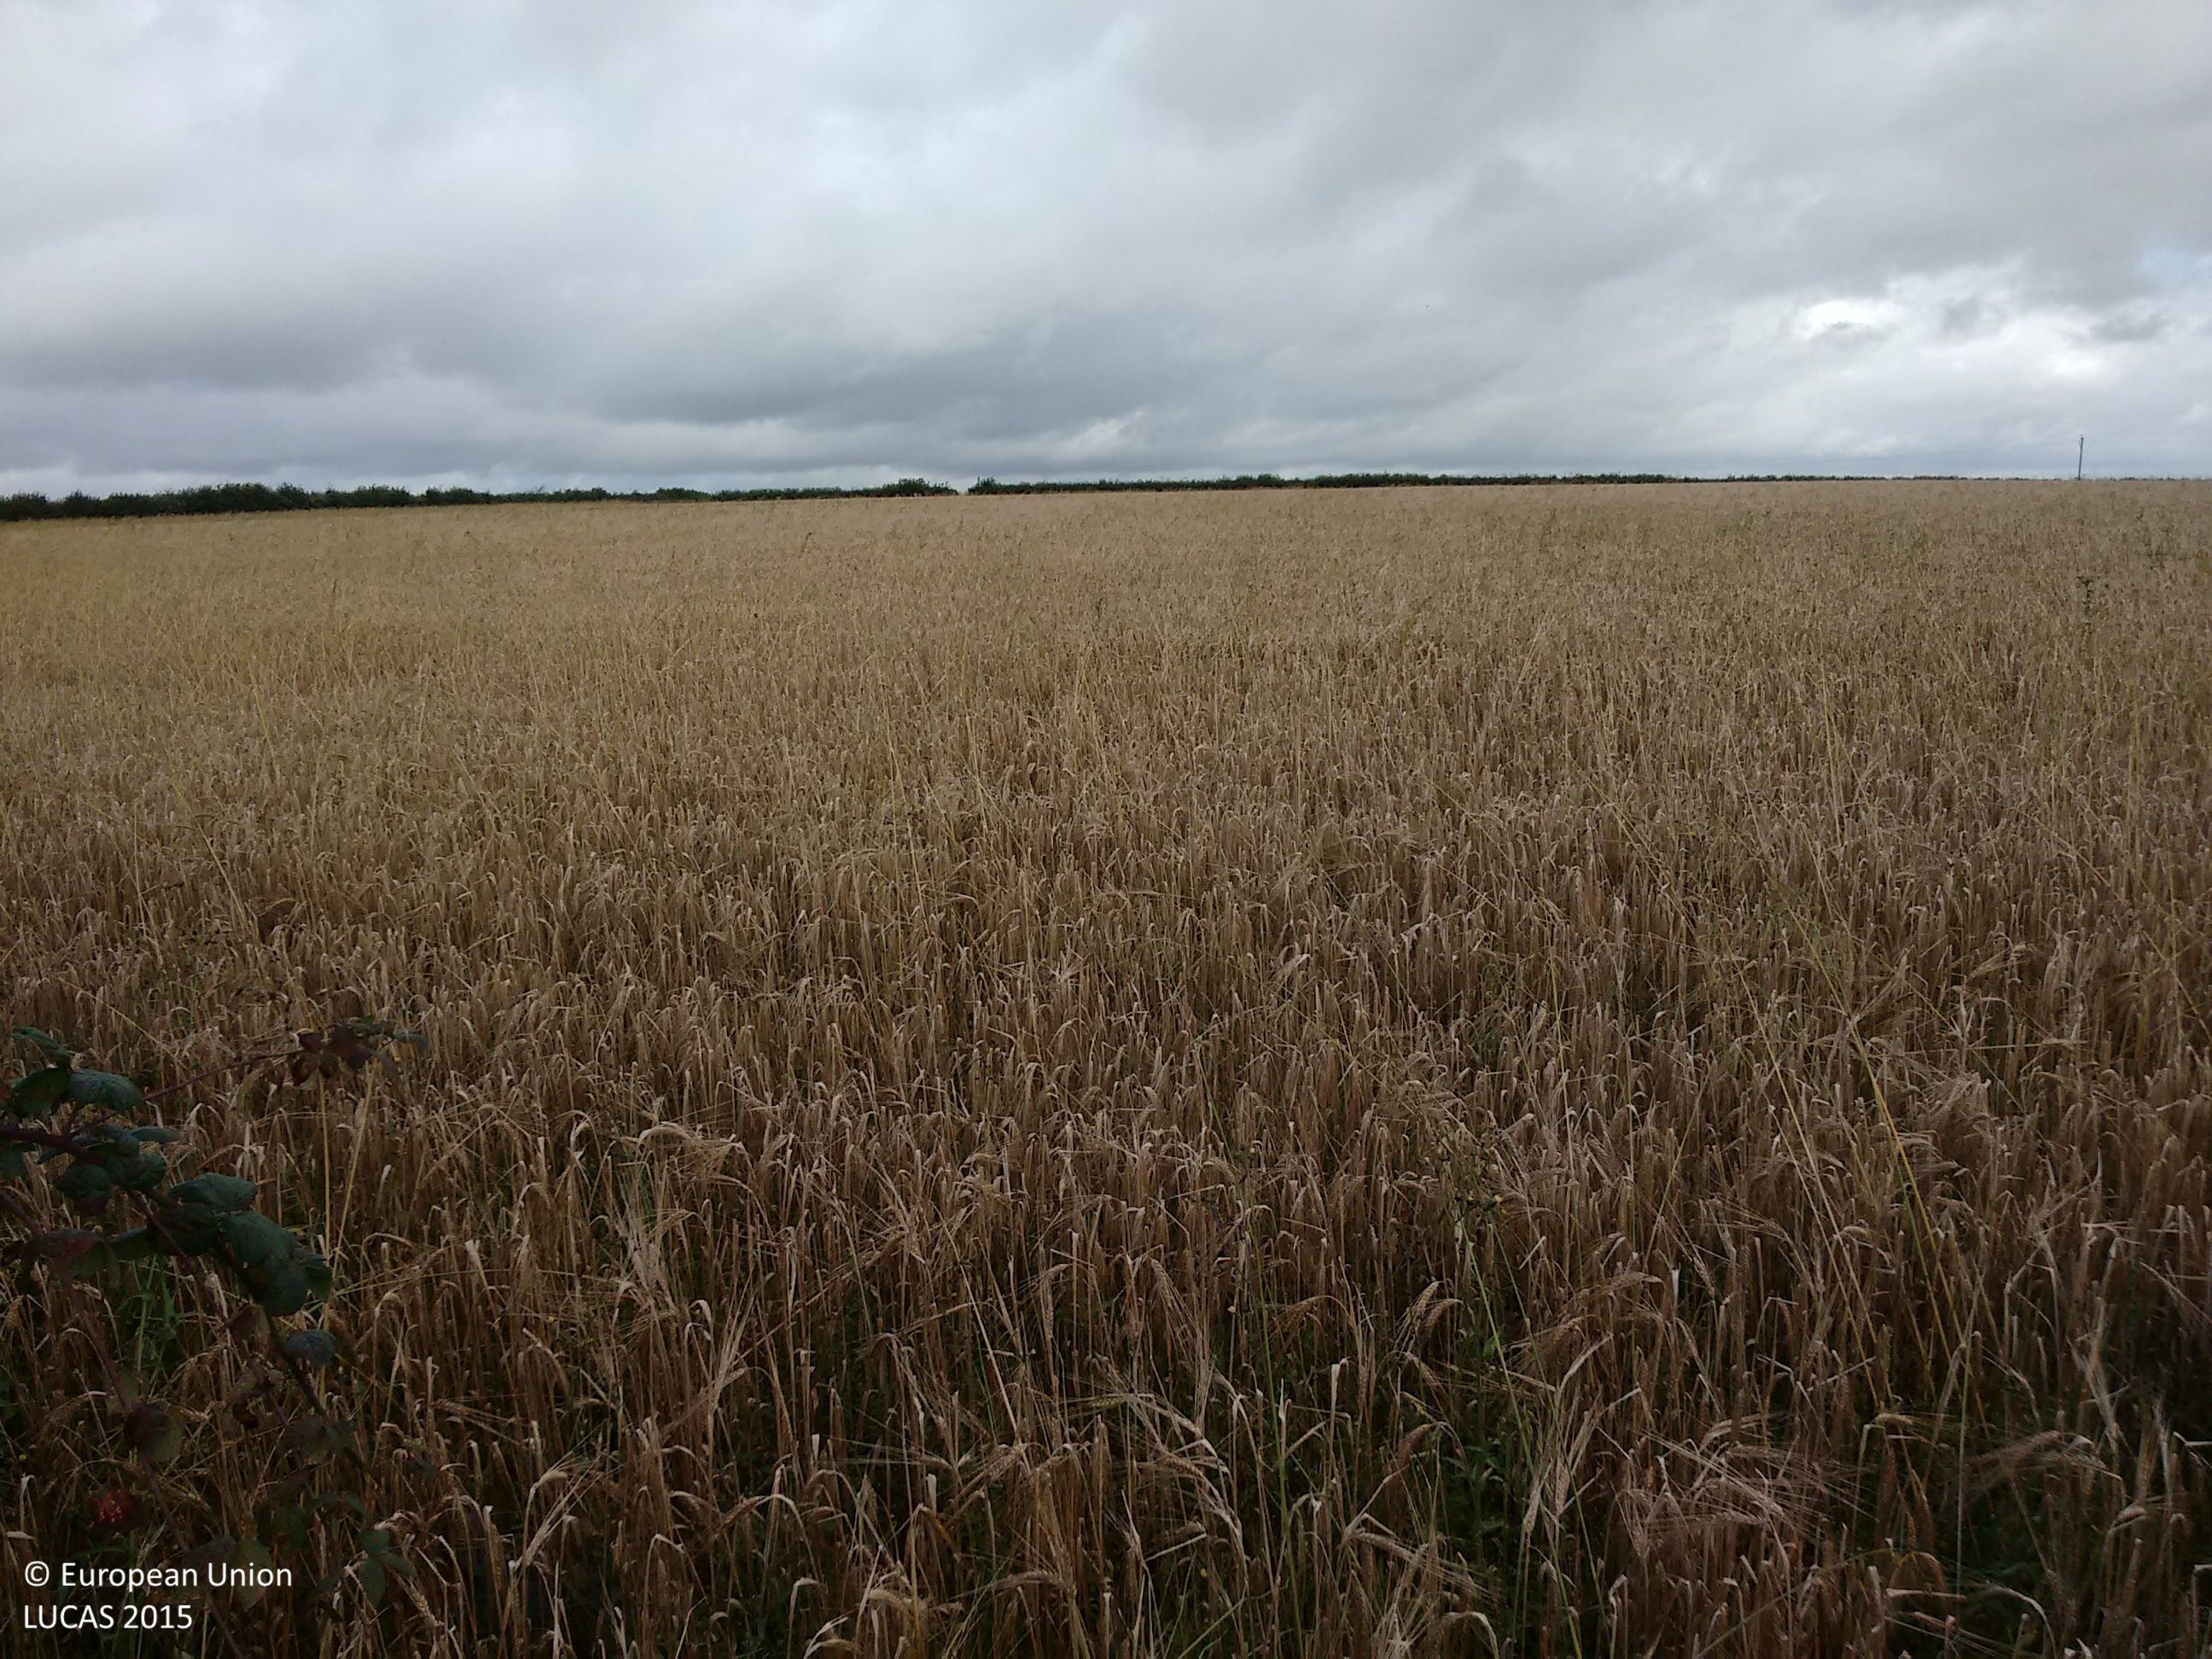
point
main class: Cropland
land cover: Barley
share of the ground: > 75 %
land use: Agriculture (excluding fallow land and kitchen gardens)
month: August
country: GB
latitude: 50.8900
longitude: -3.8087
